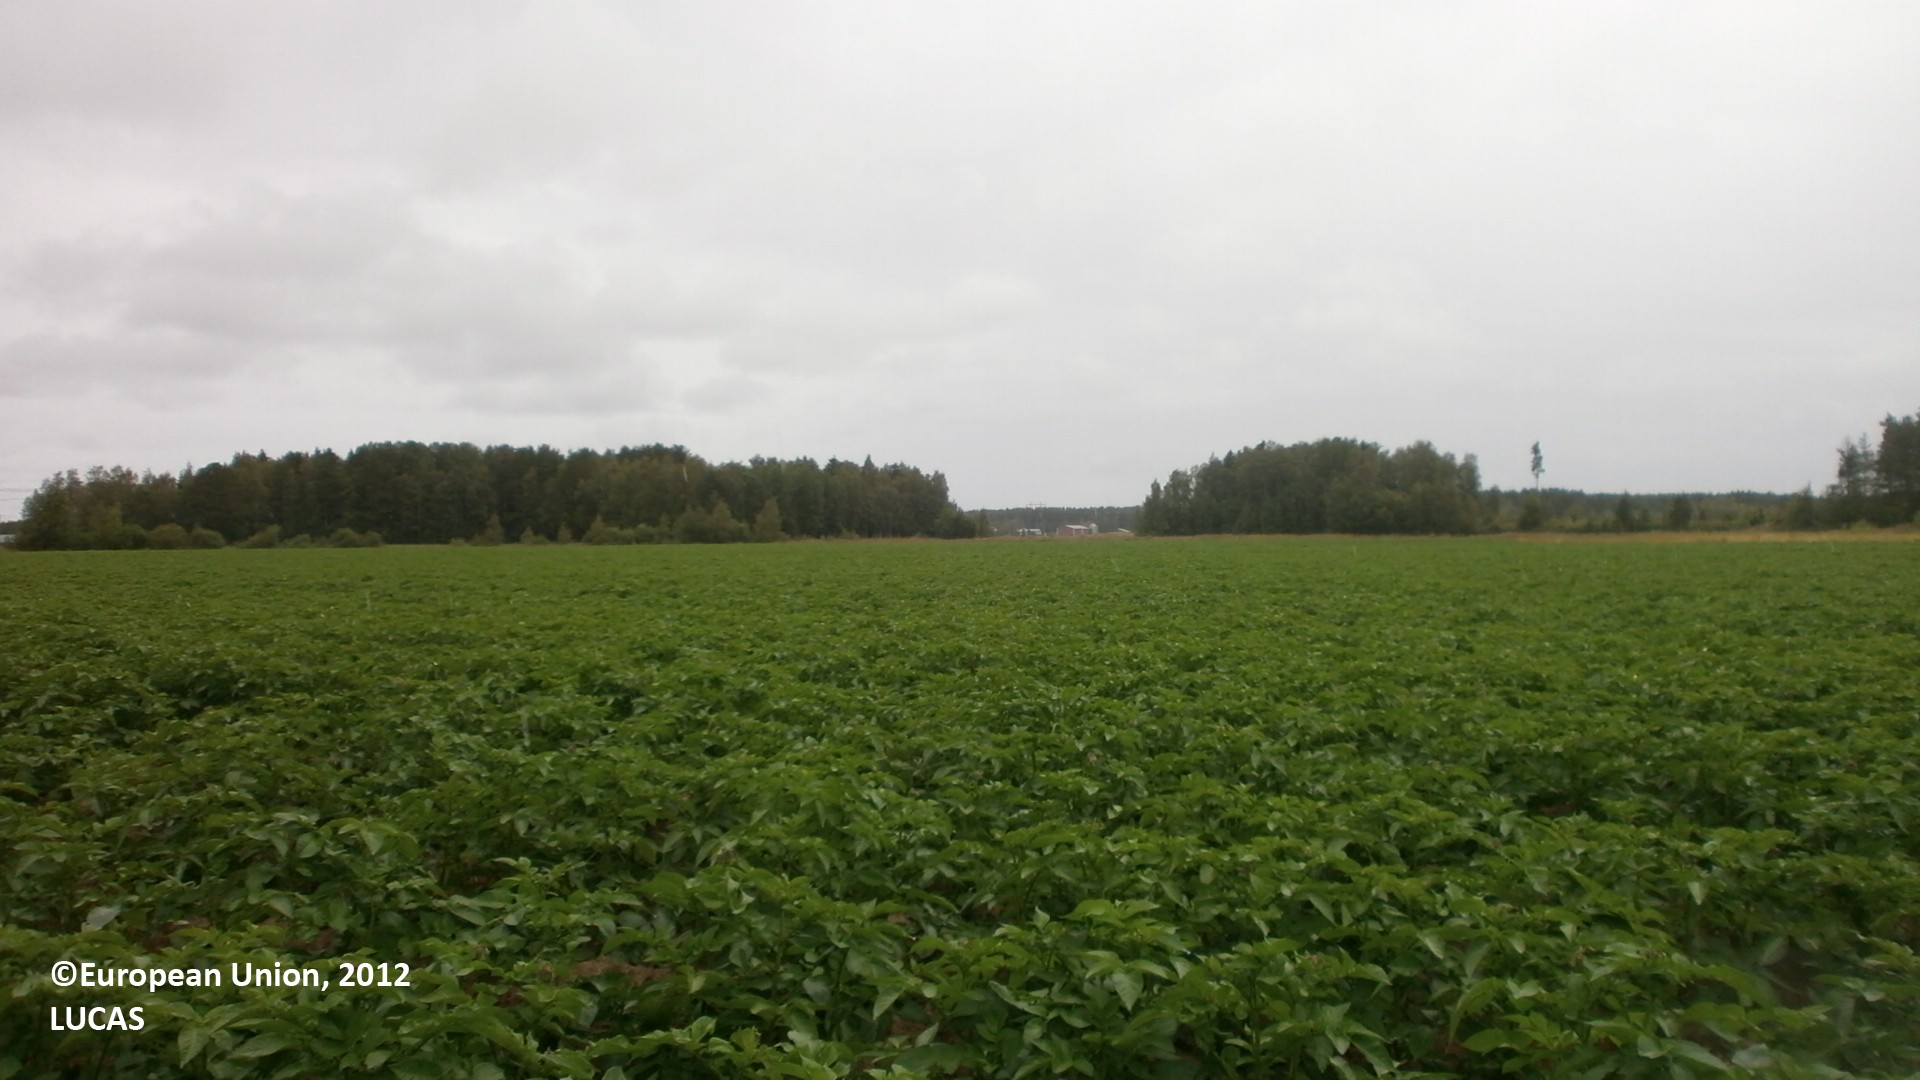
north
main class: Cropland
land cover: Potatoes
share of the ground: 50 - 75 %
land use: Agriculture (excluding fallow land and kitchen gardens)
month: July
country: FI
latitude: 64.0274
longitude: 23.6277
